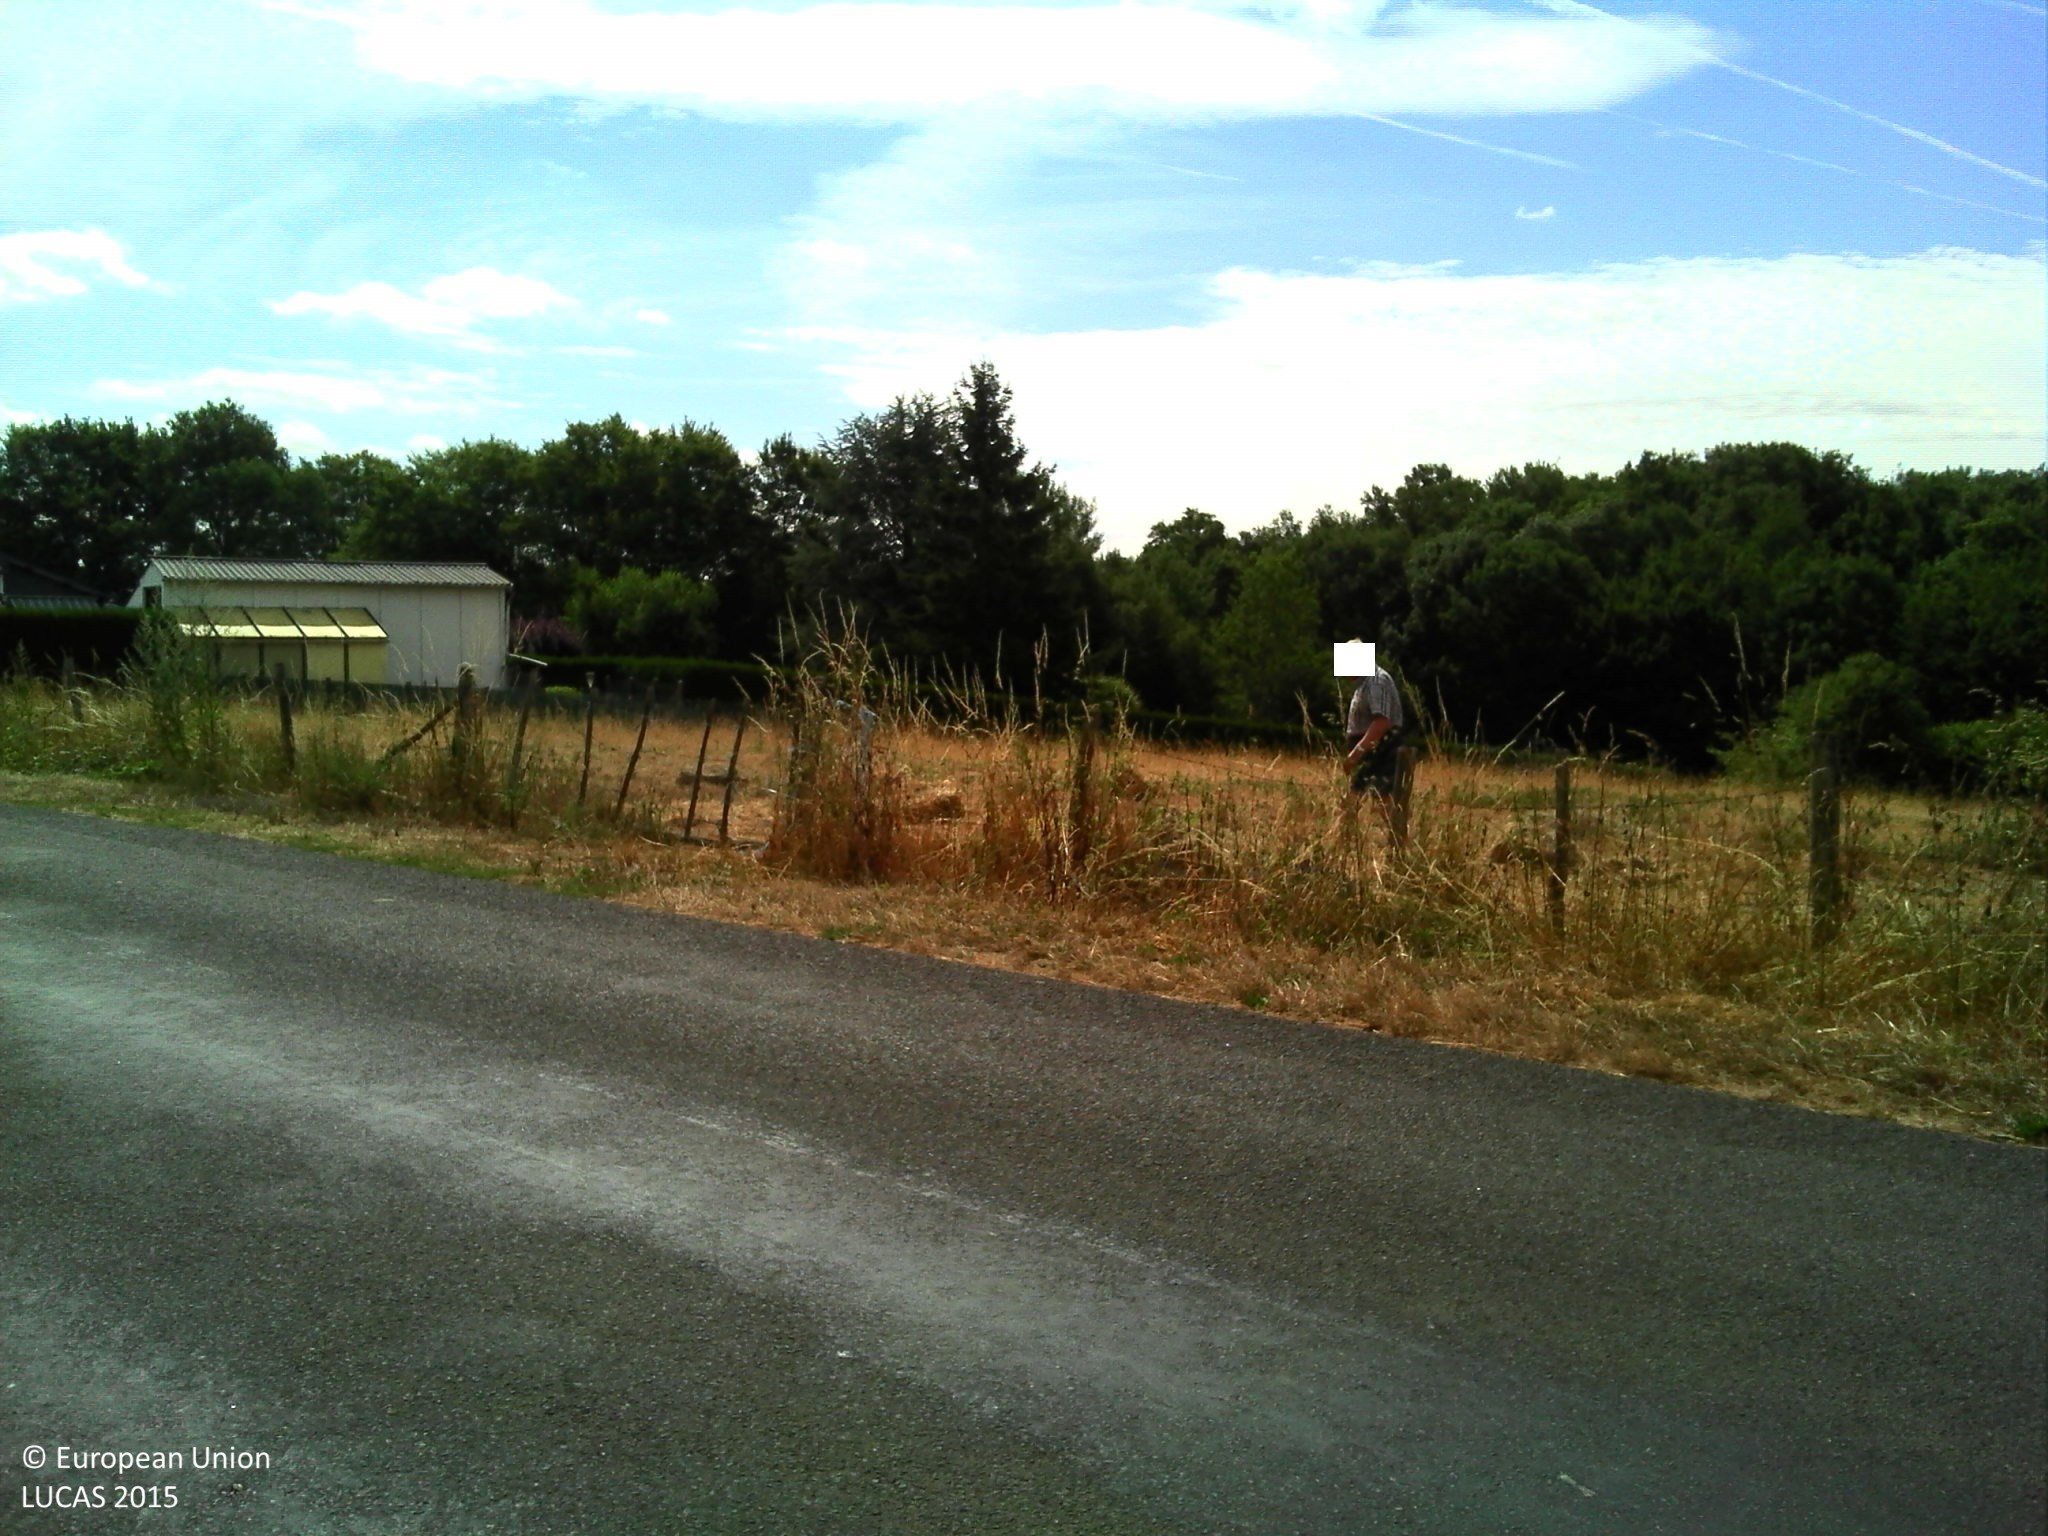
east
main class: Woodland
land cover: Broadleaved woodland
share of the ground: 50 - 75 %
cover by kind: broadleaved forest trees 45 %, herbaceous plants 40 %, shrubs 15 %
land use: Semi-natural and natural areas not in use
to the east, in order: Broadleaved woodland; Fences; Grass margins; Electric lines; Grass margins; Paved roads, cycling and walking lanes; Managed hedges; Tracks; Managed hedges; Grass margins; Electric lines; Paved roads, cycling and walking lanes
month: July
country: FR
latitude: 47.8493
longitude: 0.7179
